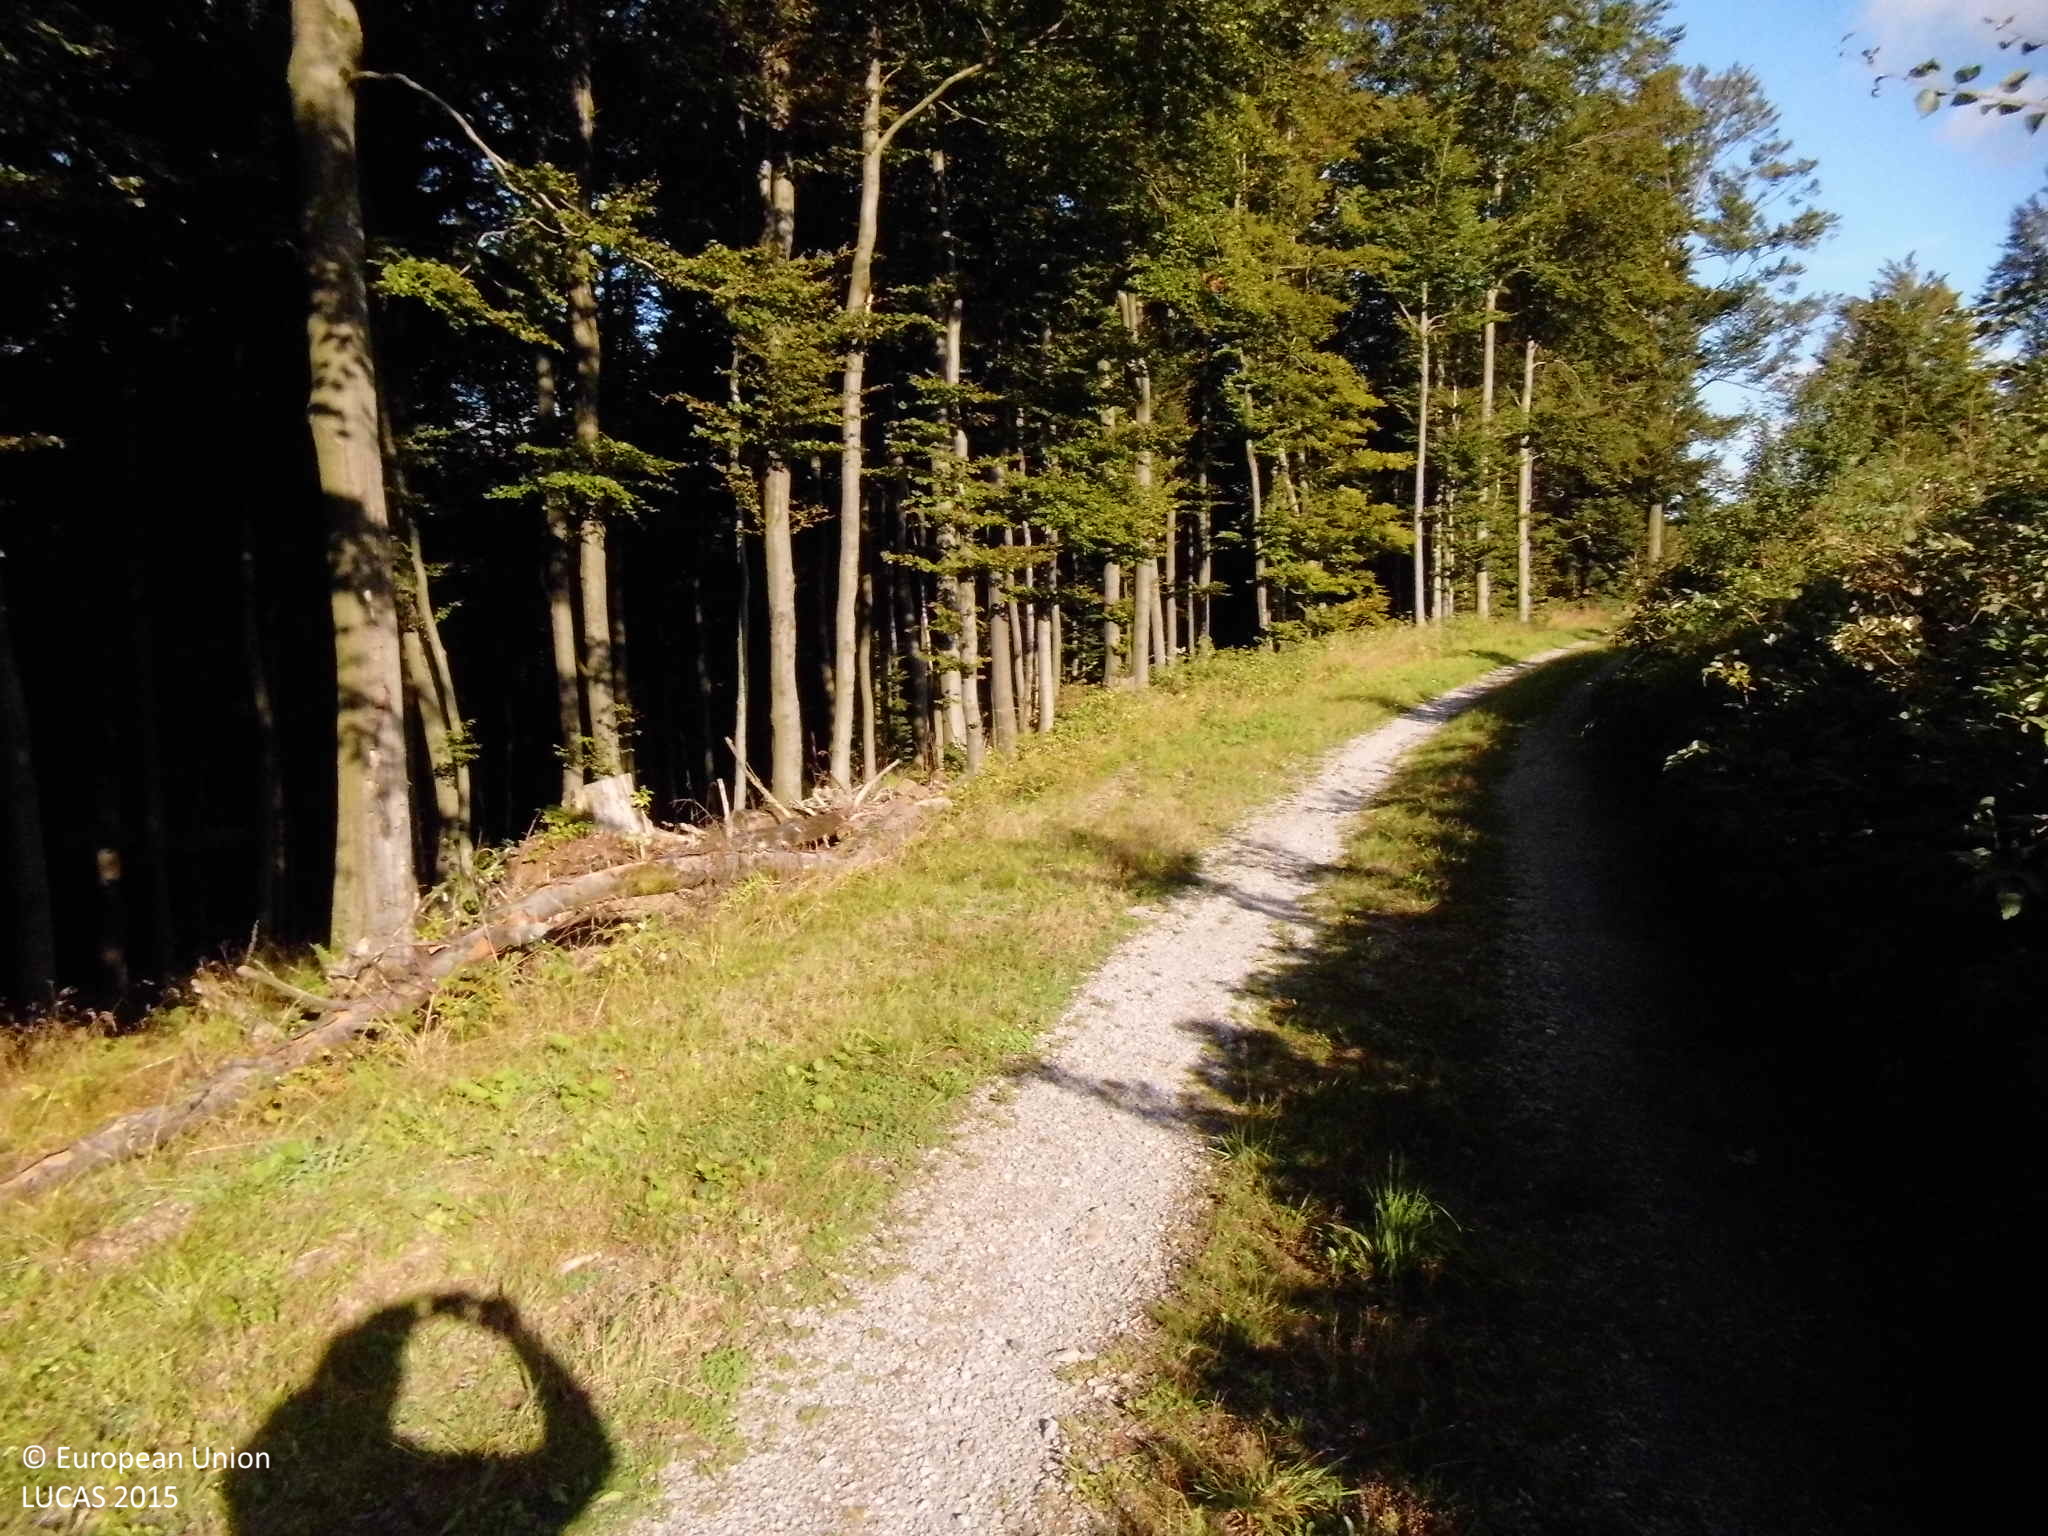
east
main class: Woodland
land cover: Spruce dominated mixed woodland
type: hemiboreal forest and nemoral coniferous forest and mixed broadleaved-coniferous forest
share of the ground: 25 - 50 %
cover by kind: shrubs 50 %, coniferous forest trees 35 %, broadleaved forest trees 15 %
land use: Forestry
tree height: < 5 m
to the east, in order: Spruce dominated mixed woodland; Tracks; Grass margins; Broadleaved woodland; Spruce dominated coniferous woodland; Tracks; Spruce dominated coniferous woodland; Tracks; Spruce dominated coniferous woodland; Spruce dominated mixed woodland
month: September
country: DE
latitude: 51.3083
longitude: 8.5802
